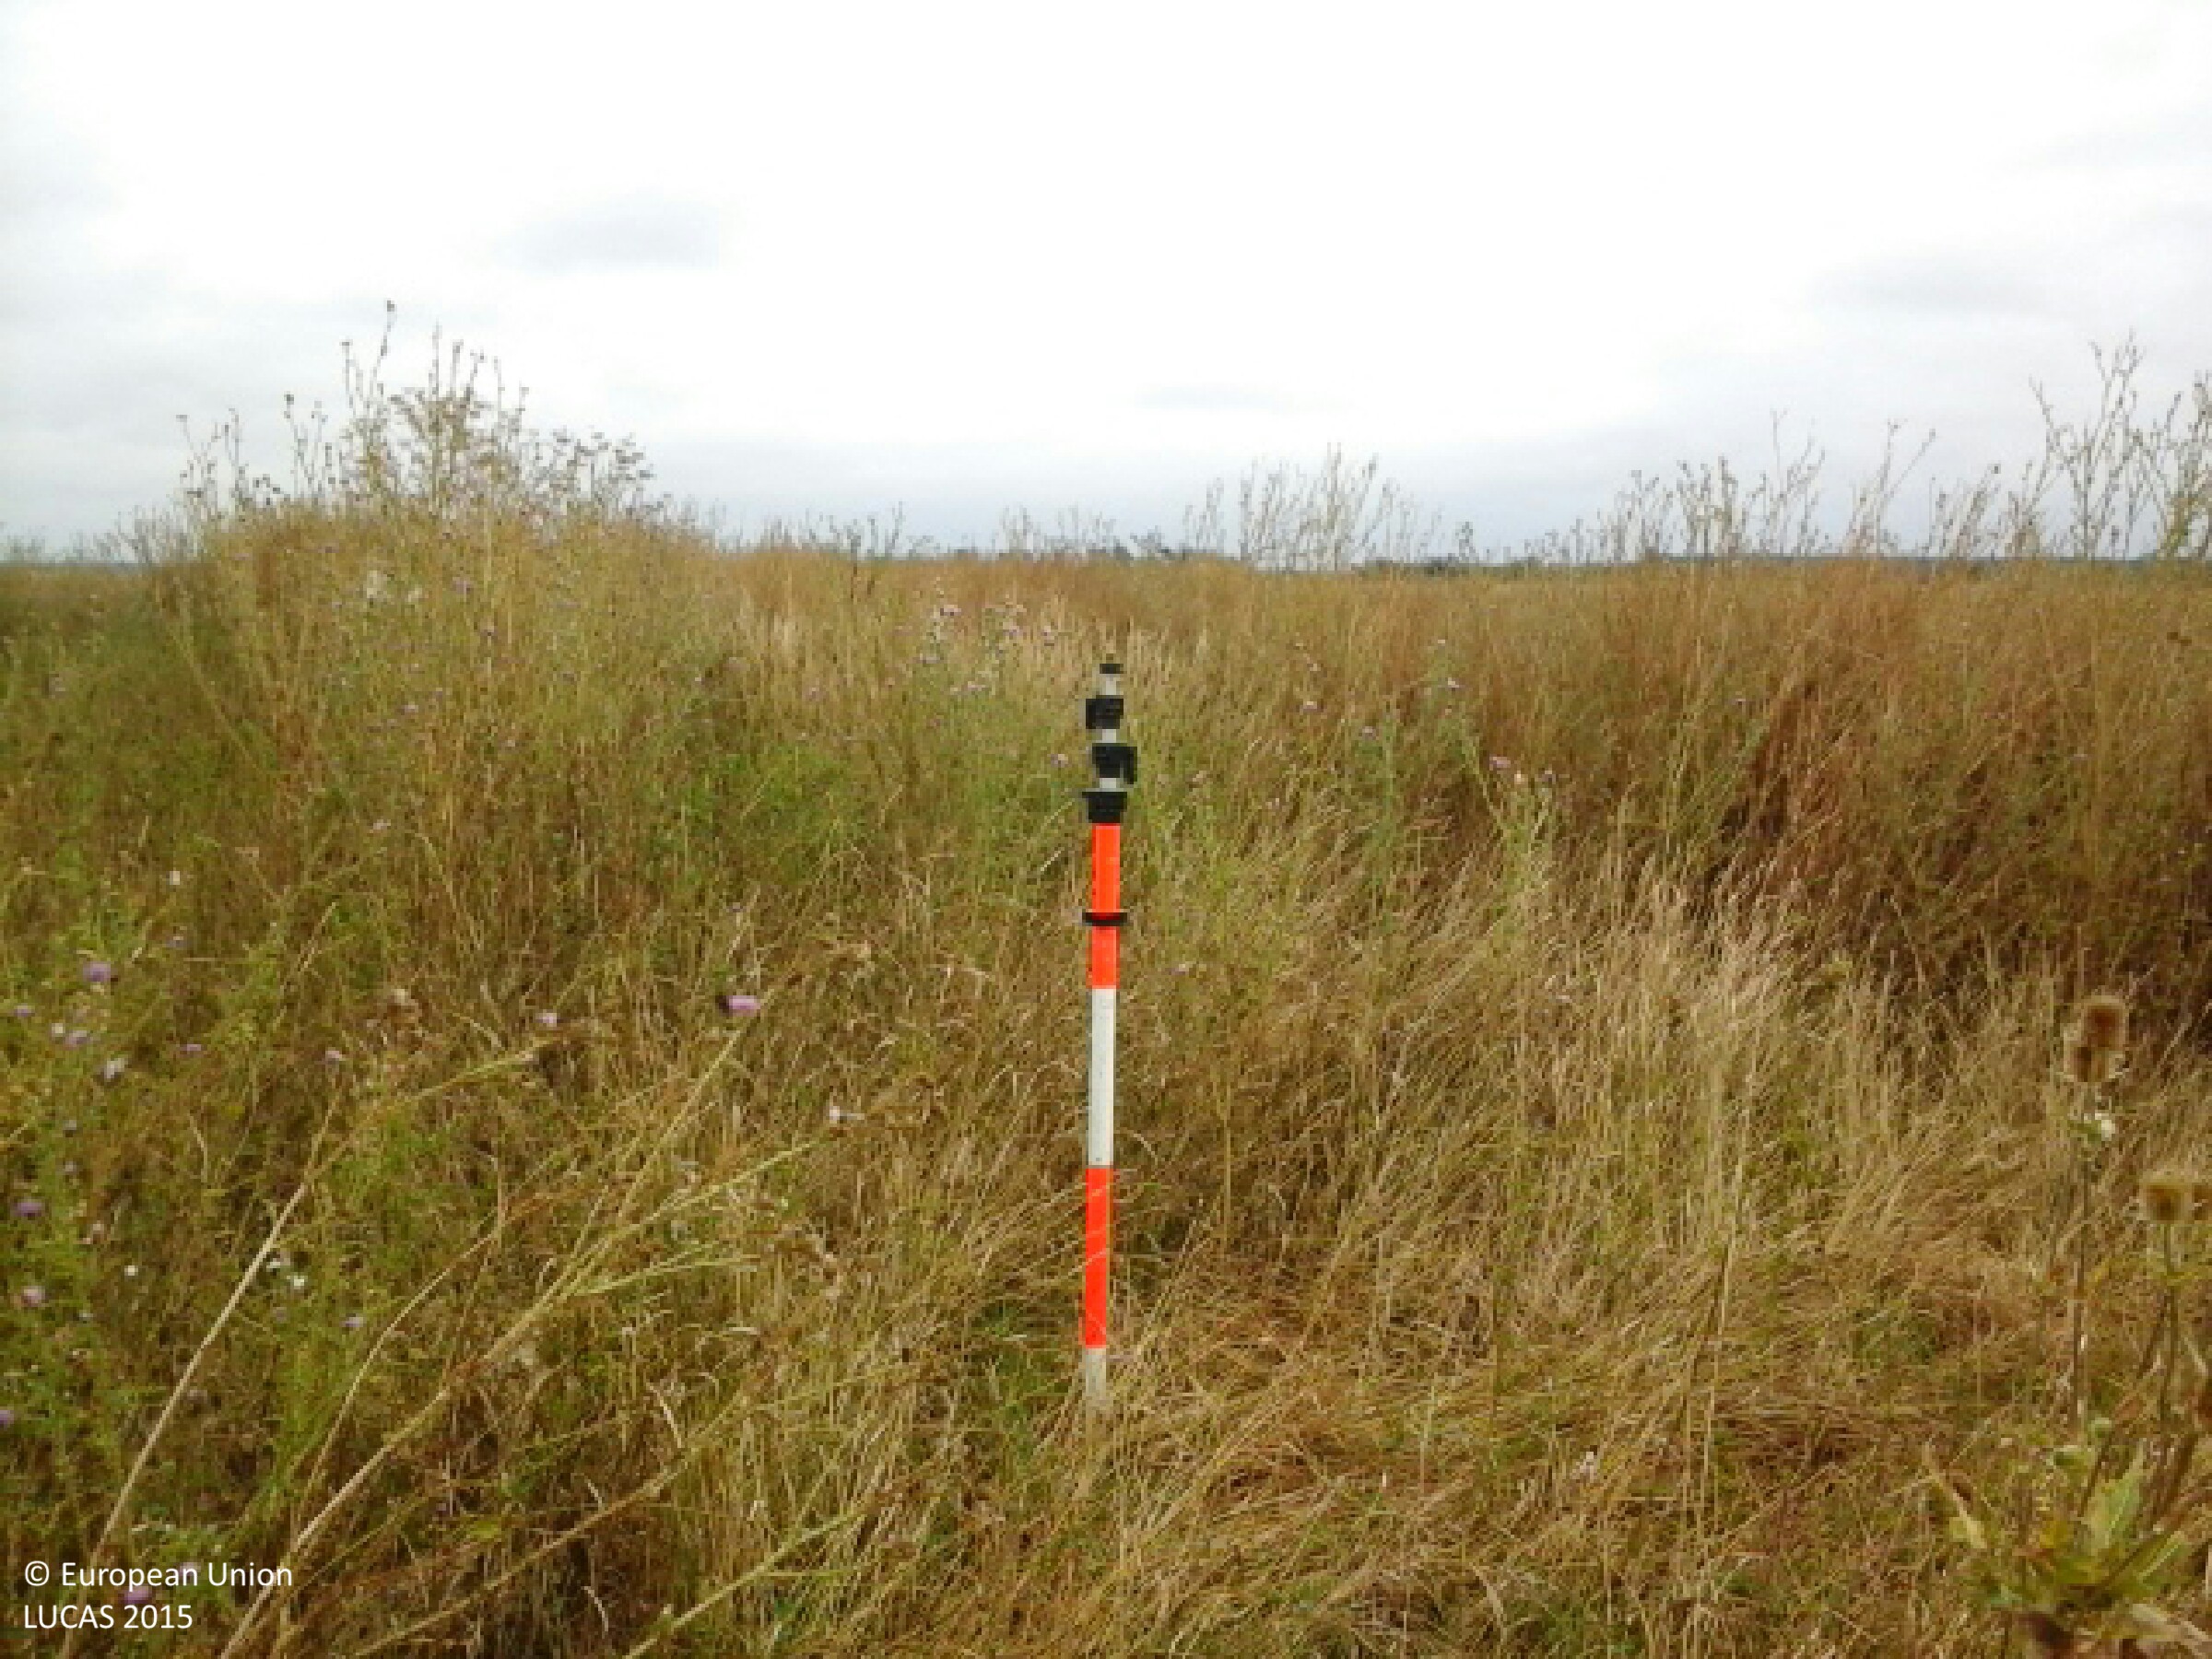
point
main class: Grassland
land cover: Spontaneously vegetated surfaces
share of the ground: > 75 %
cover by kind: herbaceous plants 100 %
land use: Semi-natural and natural areas not in use
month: August
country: HU
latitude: 47.1562
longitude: 21.5831
